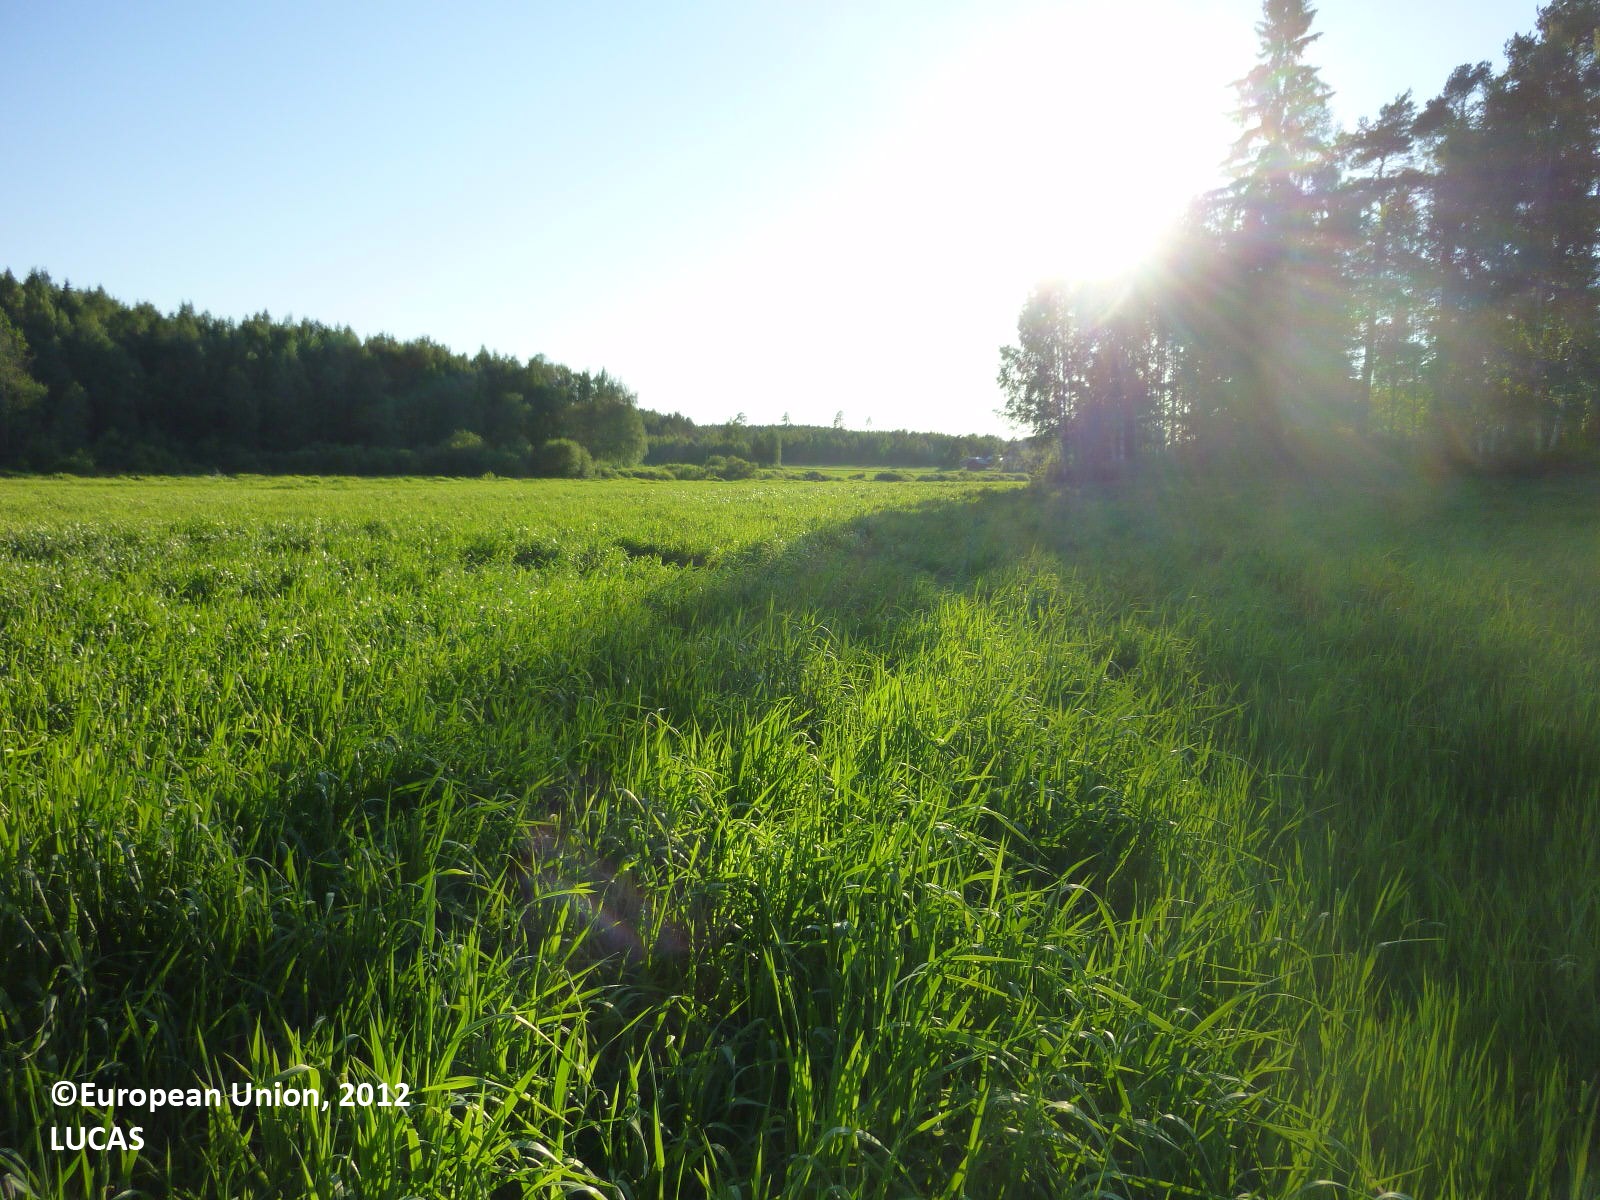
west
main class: Cropland
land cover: Temporary grasslands
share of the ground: > 75 %
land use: Agriculture (excluding fallow land and kitchen gardens)
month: June
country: FI
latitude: 61.6458
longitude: 22.1183
